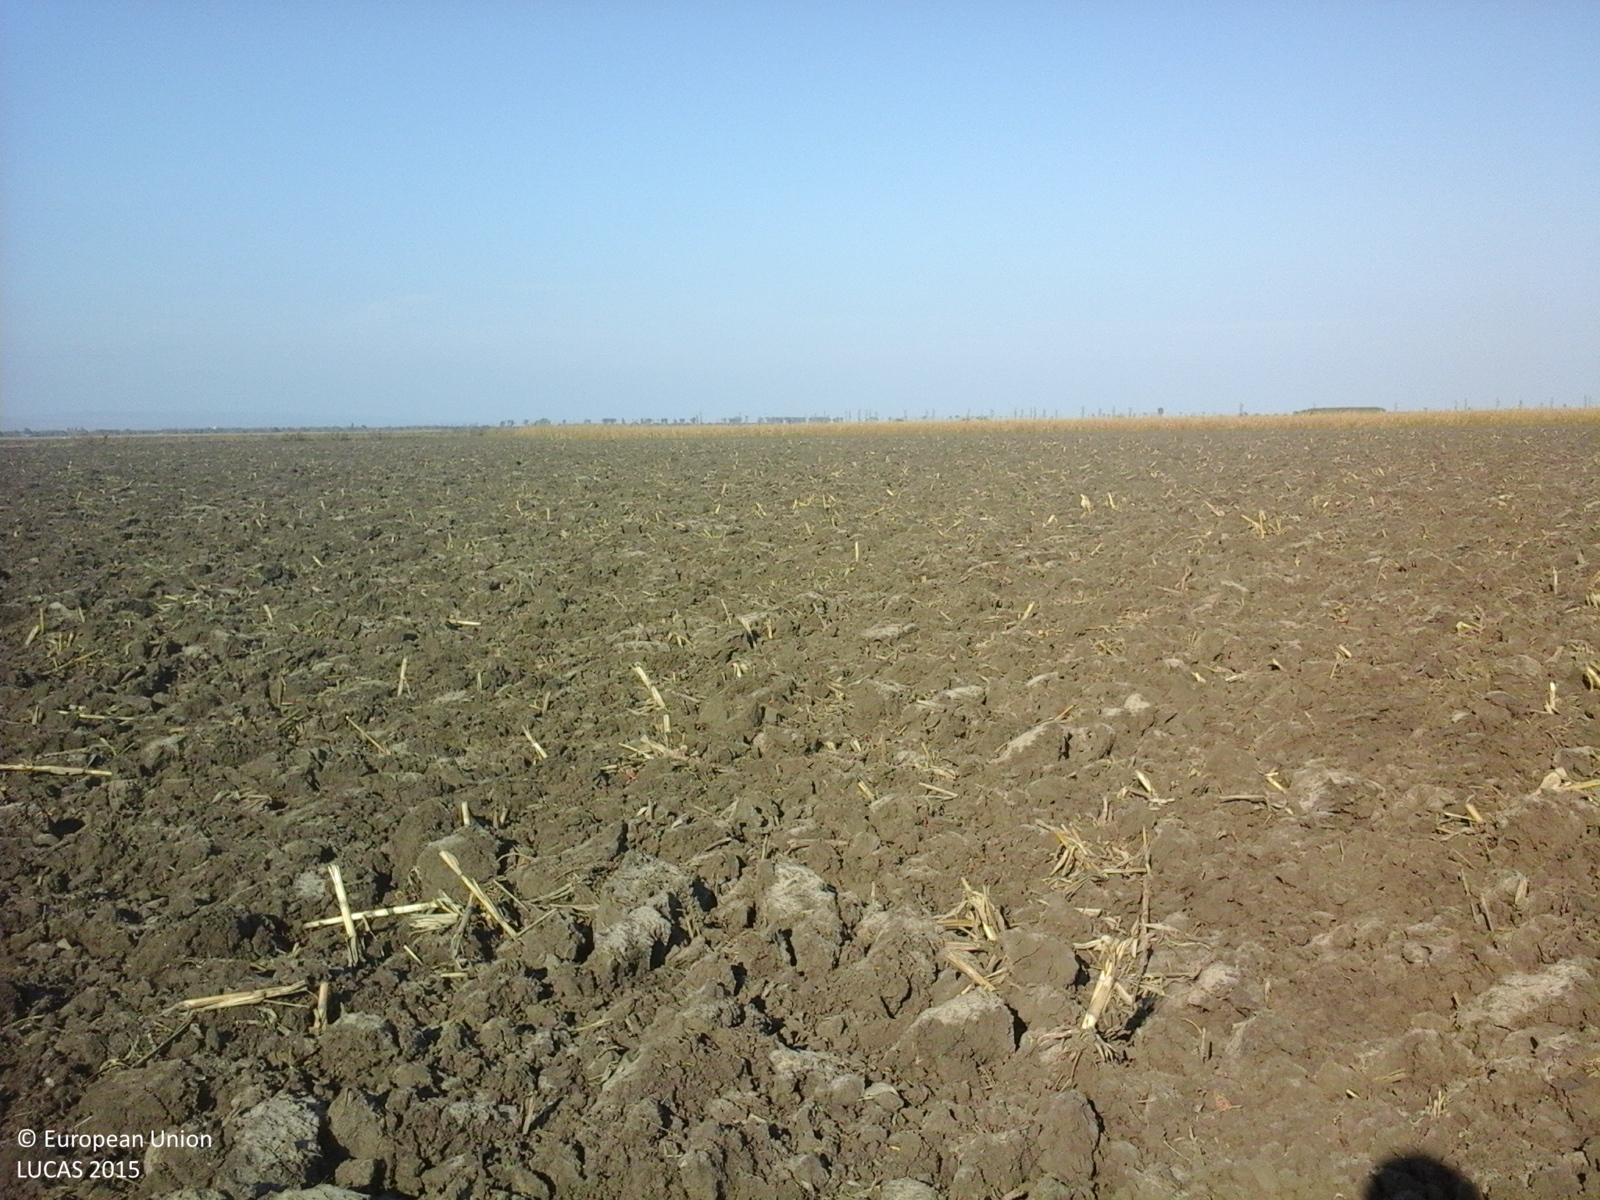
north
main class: Cropland
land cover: Maize
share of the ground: < 10 %
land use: Agriculture (excluding fallow land and kitchen gardens)
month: October
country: RO
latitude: 45.1627
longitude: 26.9921
